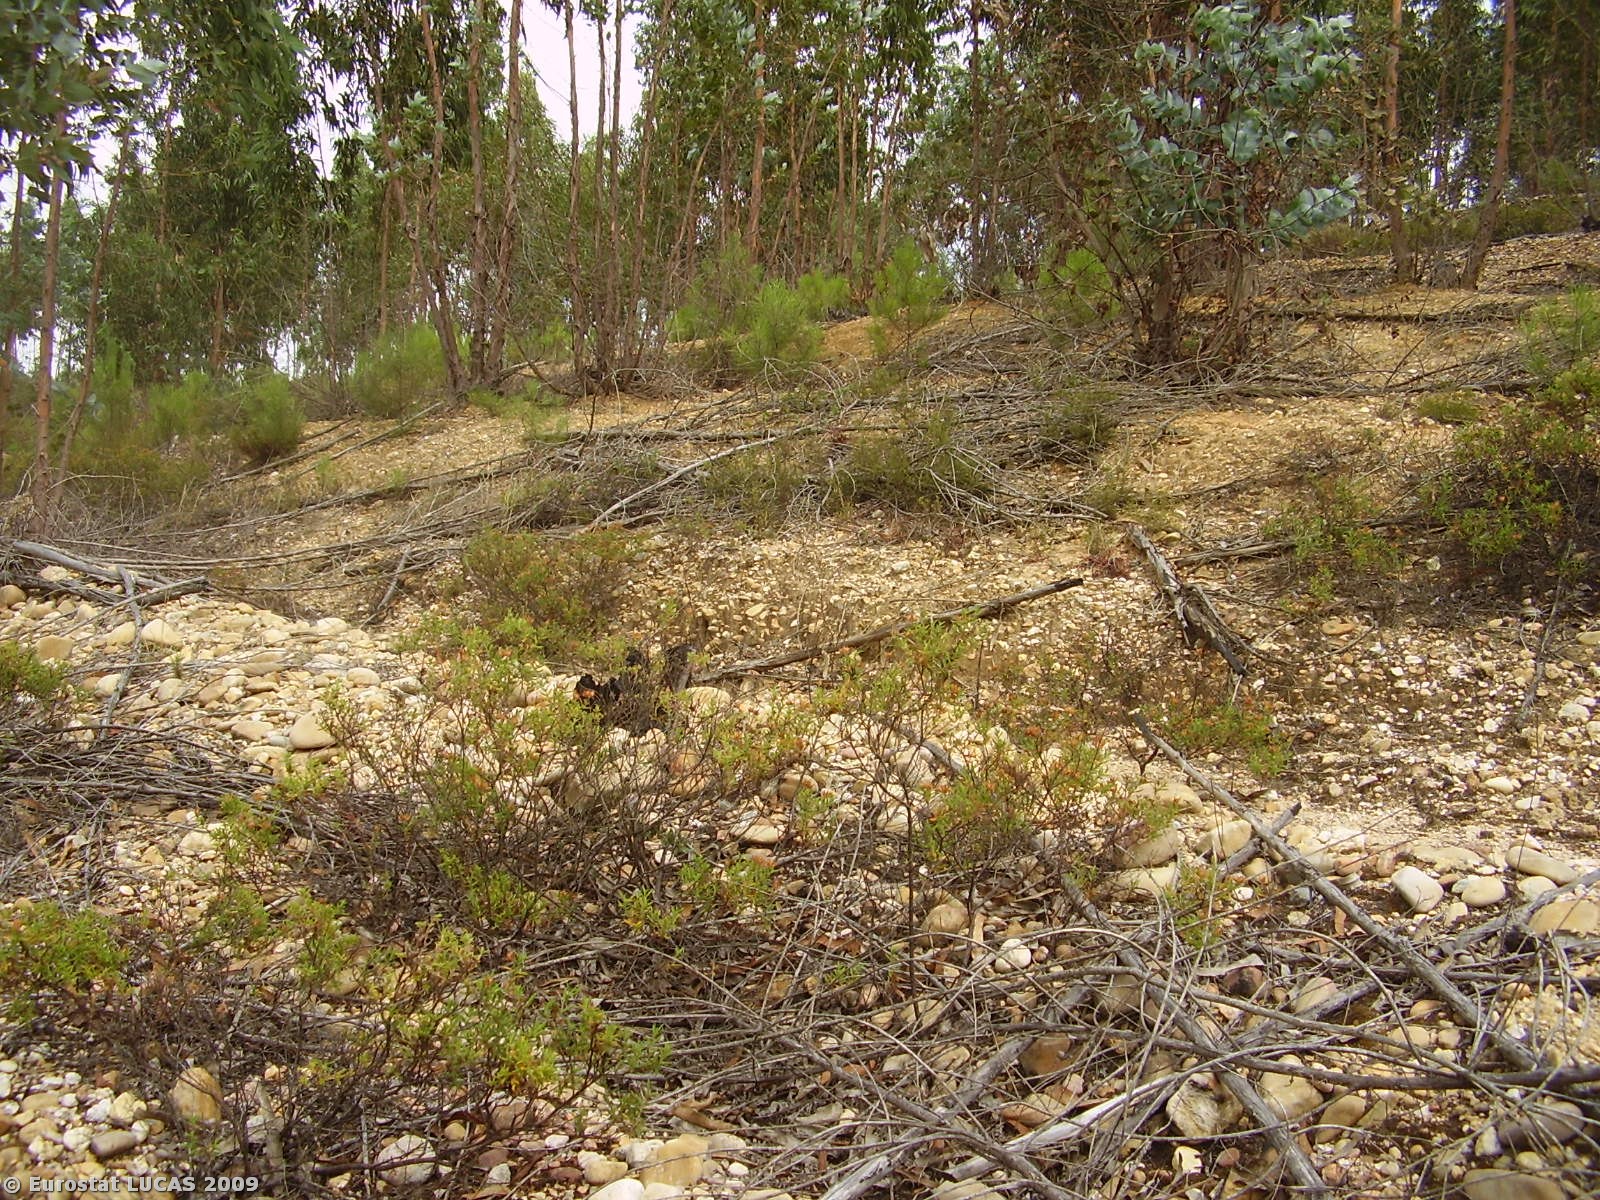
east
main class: Woodland
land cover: Broadleaved woodland
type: plantations and self-sown exotic forest
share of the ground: 25 - 50 %
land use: Forestry
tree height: > 5 m
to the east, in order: Broadleaved woodland; Tracks; Shrubland with sparse tree cover
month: July
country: PT
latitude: 39.4847
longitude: -8.2372
